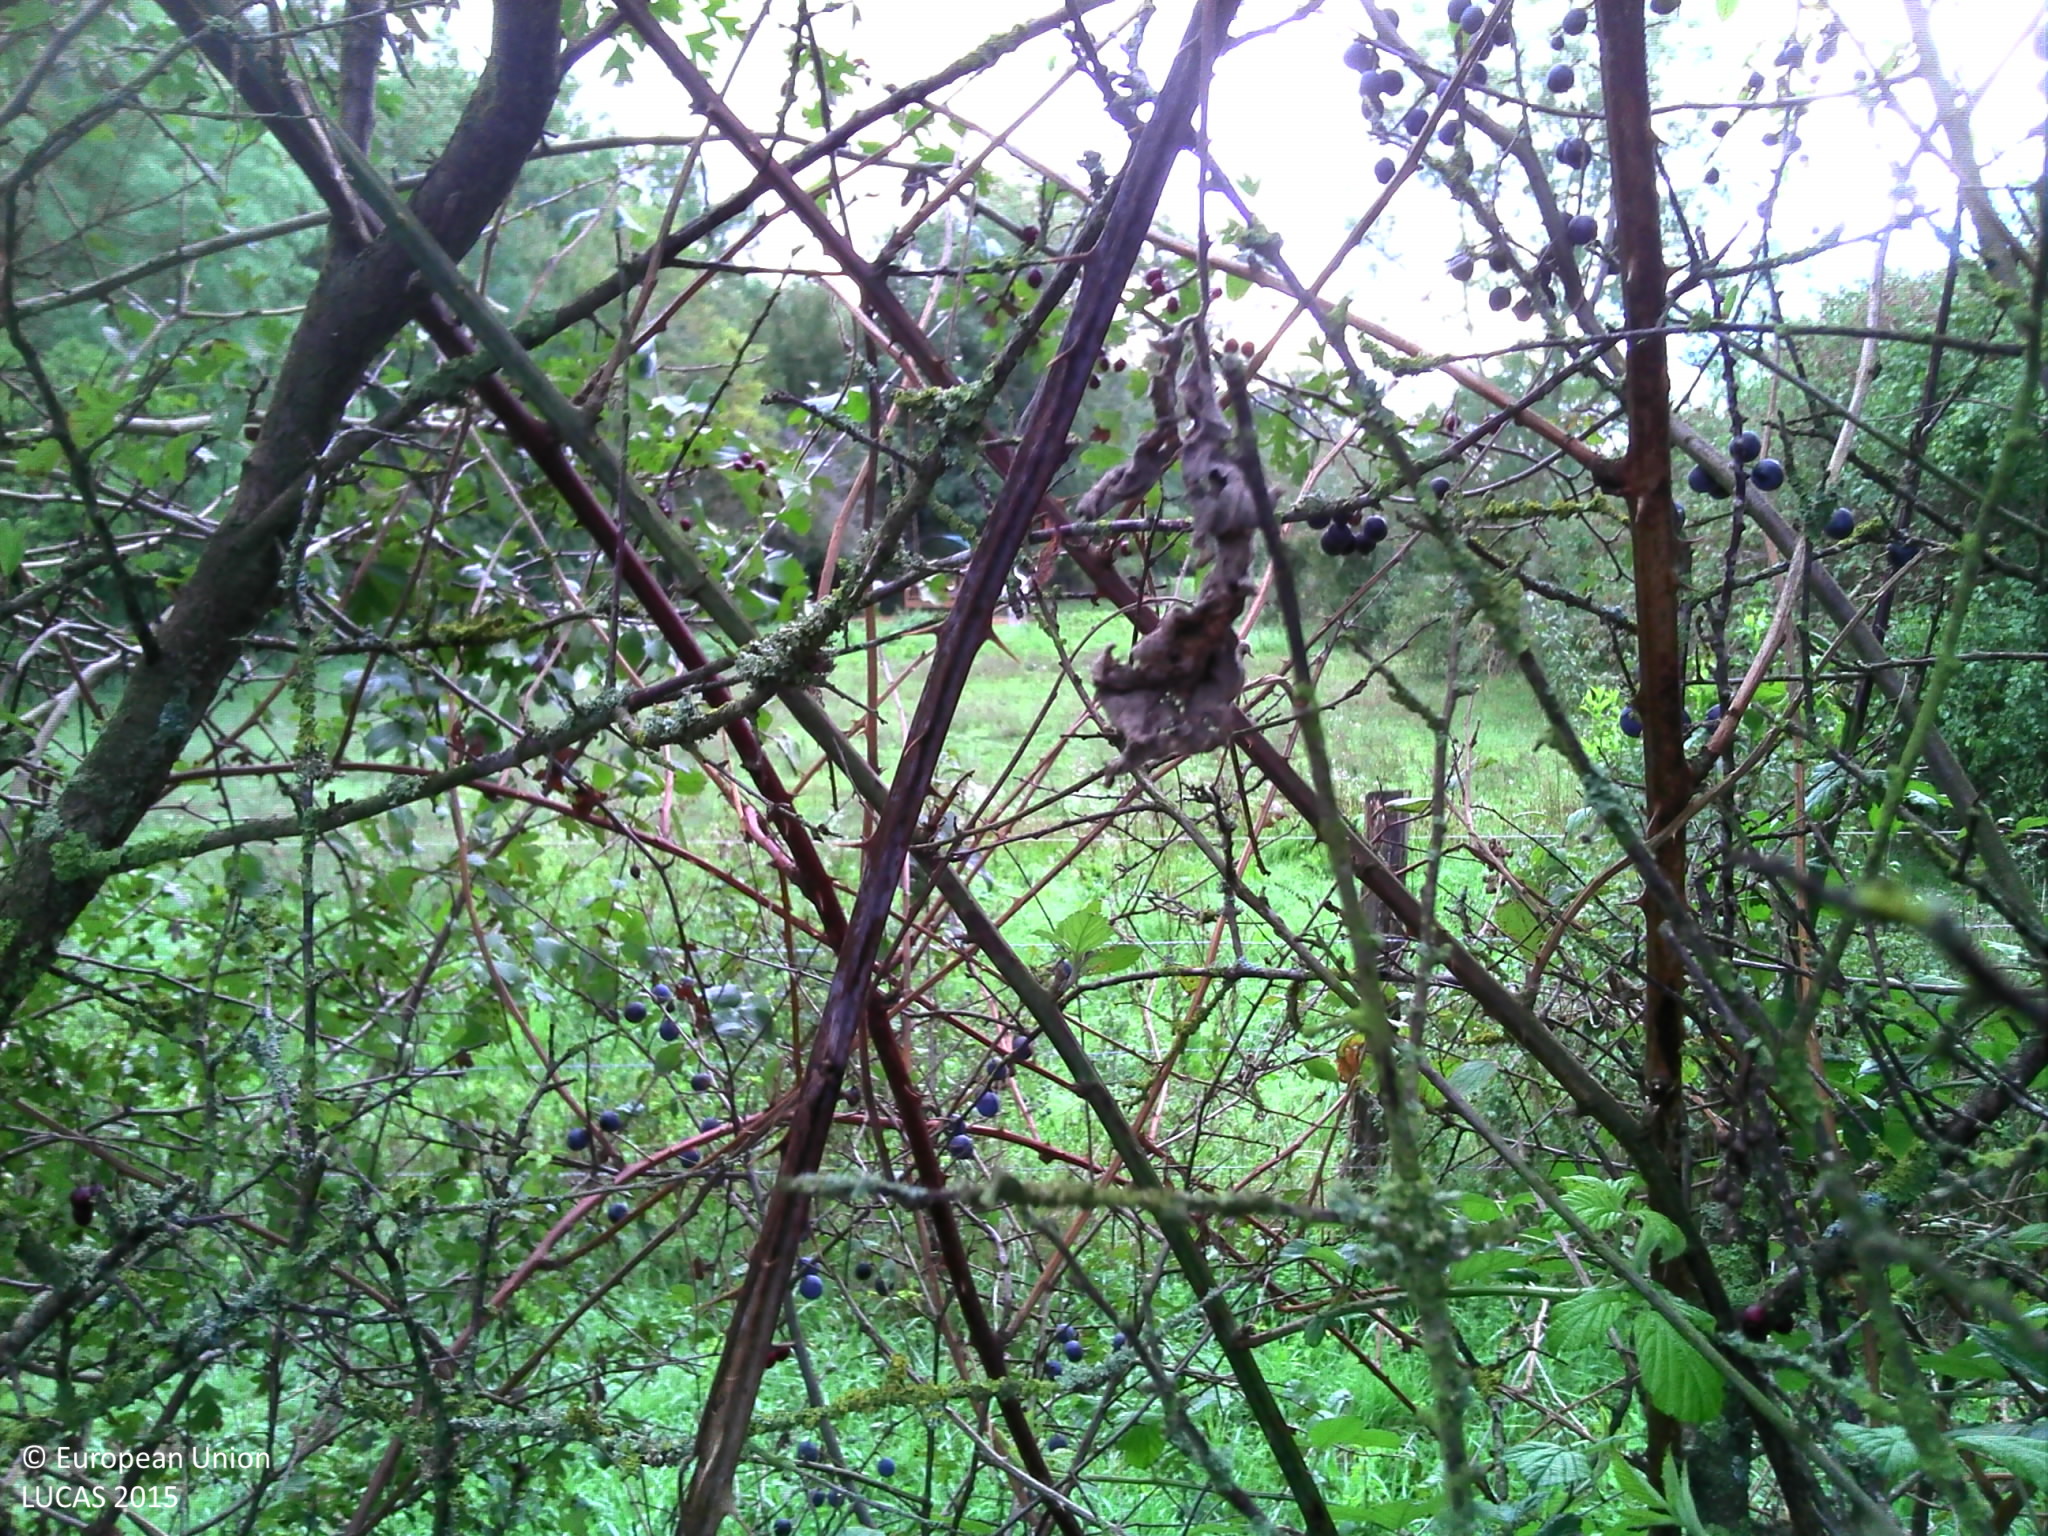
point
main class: Grassland
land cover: Grassland without tree/shrub cover
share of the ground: > 75 %
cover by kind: herbaceous plants 100 %
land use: Agriculture (excluding fallow land and kitchen gardens)
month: September
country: FR
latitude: 47.0814
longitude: 4.9827
